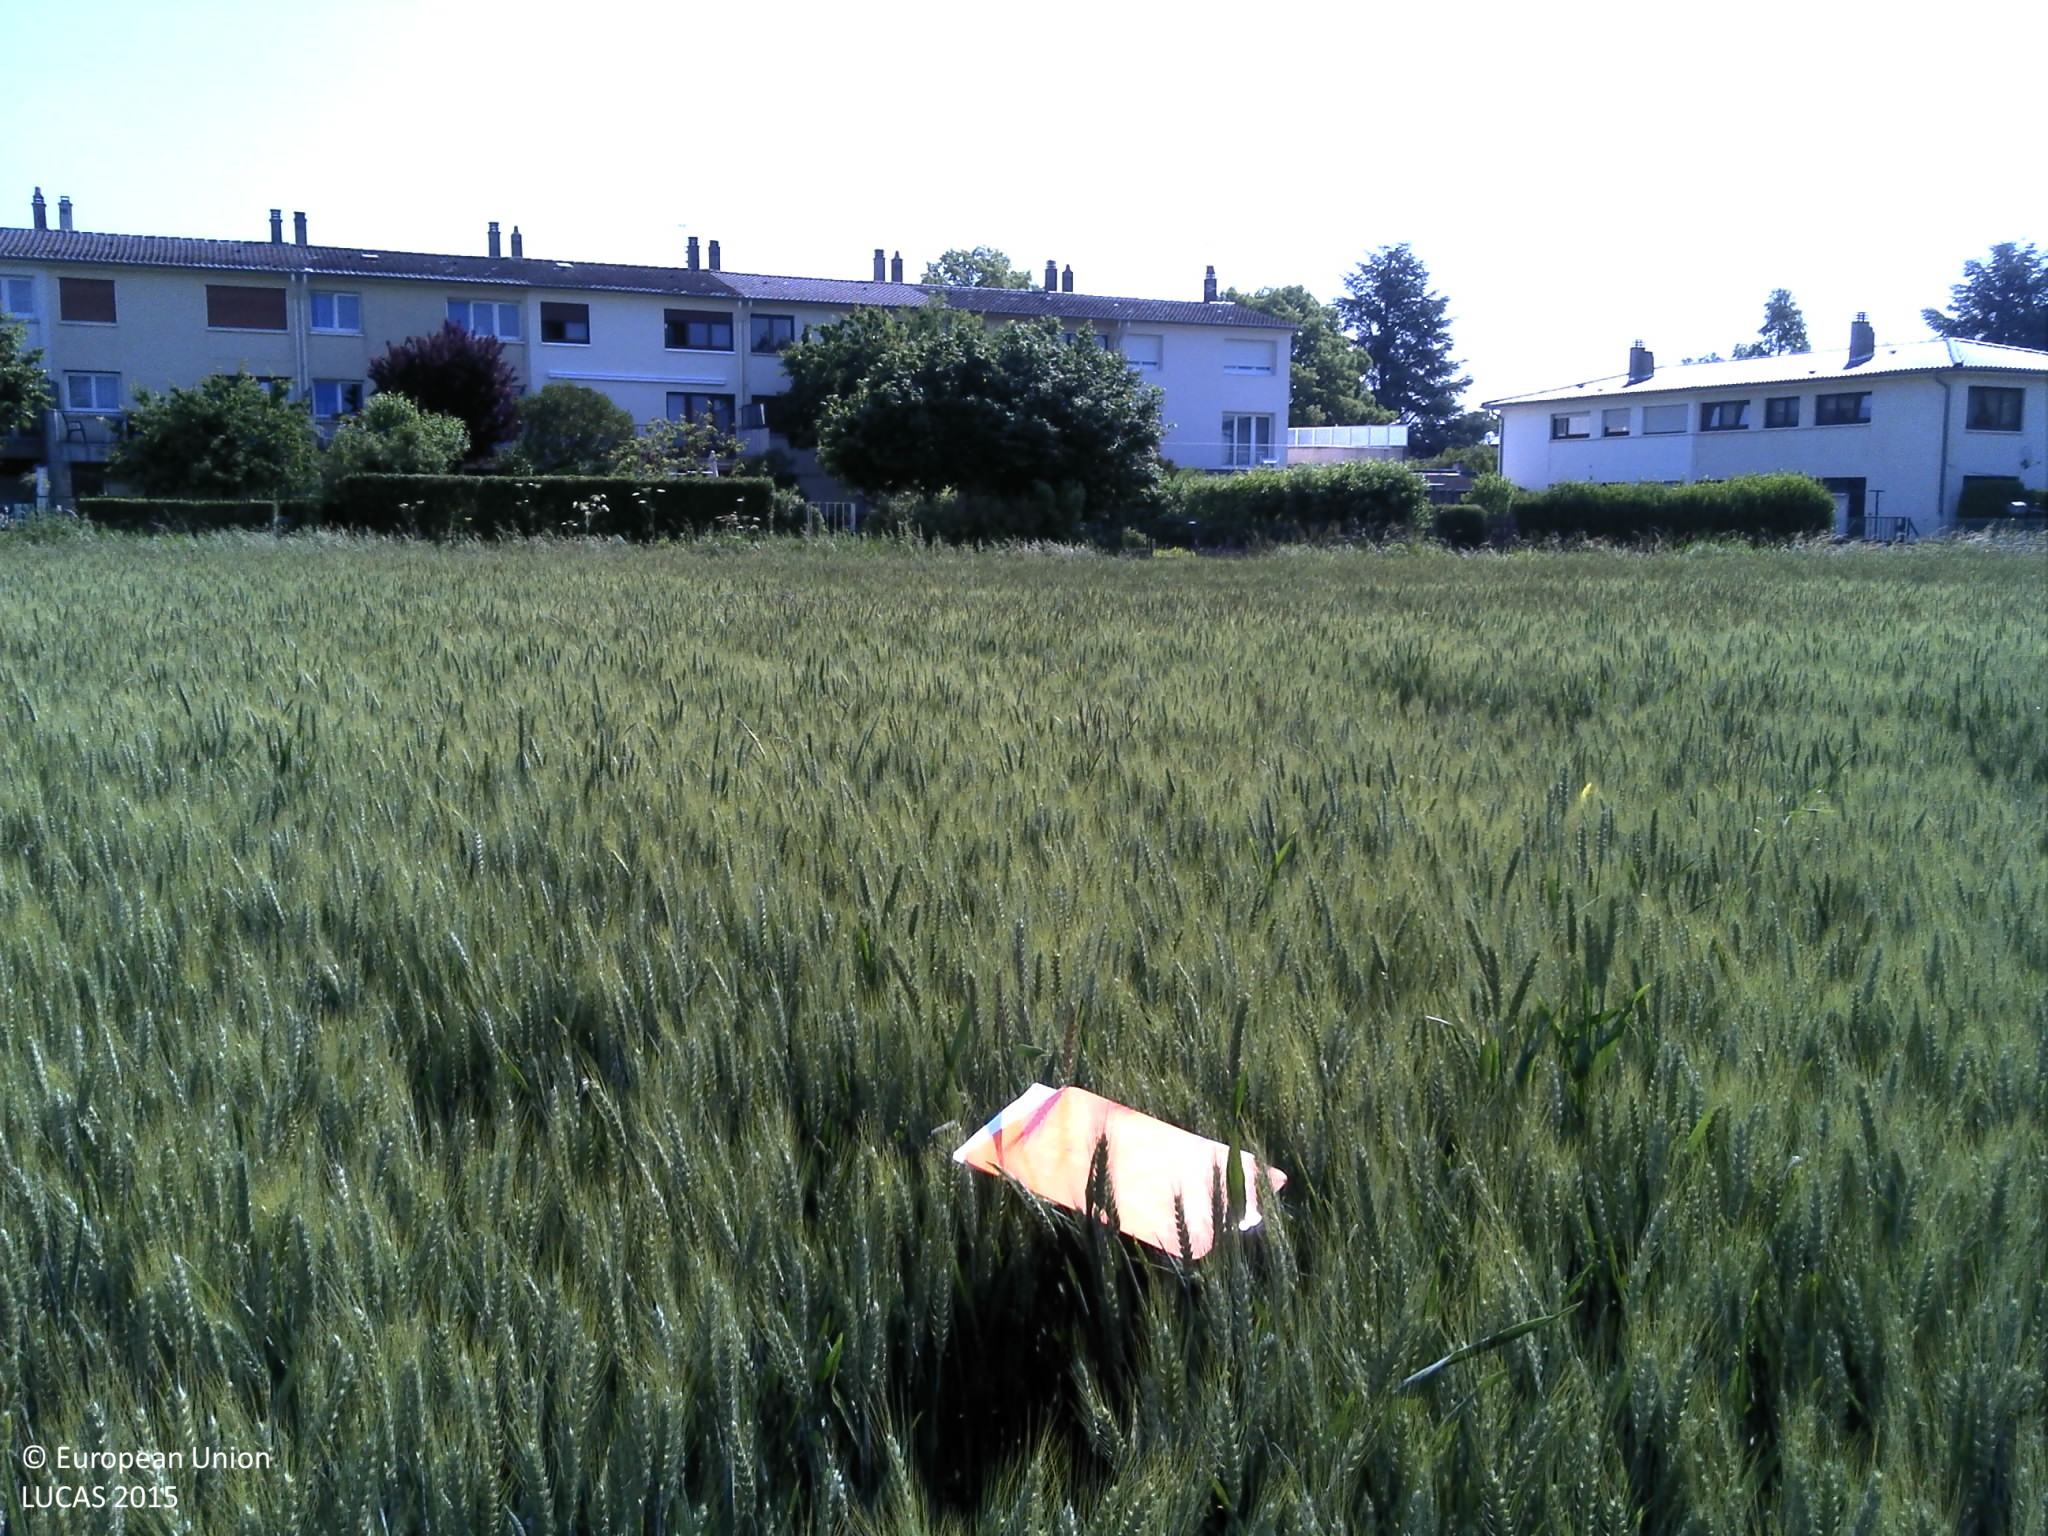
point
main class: Cropland
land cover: Common wheat
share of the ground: > 75 %
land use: Agriculture (excluding fallow land and kitchen gardens)
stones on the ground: < 10 %
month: June
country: FR
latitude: 49.0571
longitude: 6.1544
